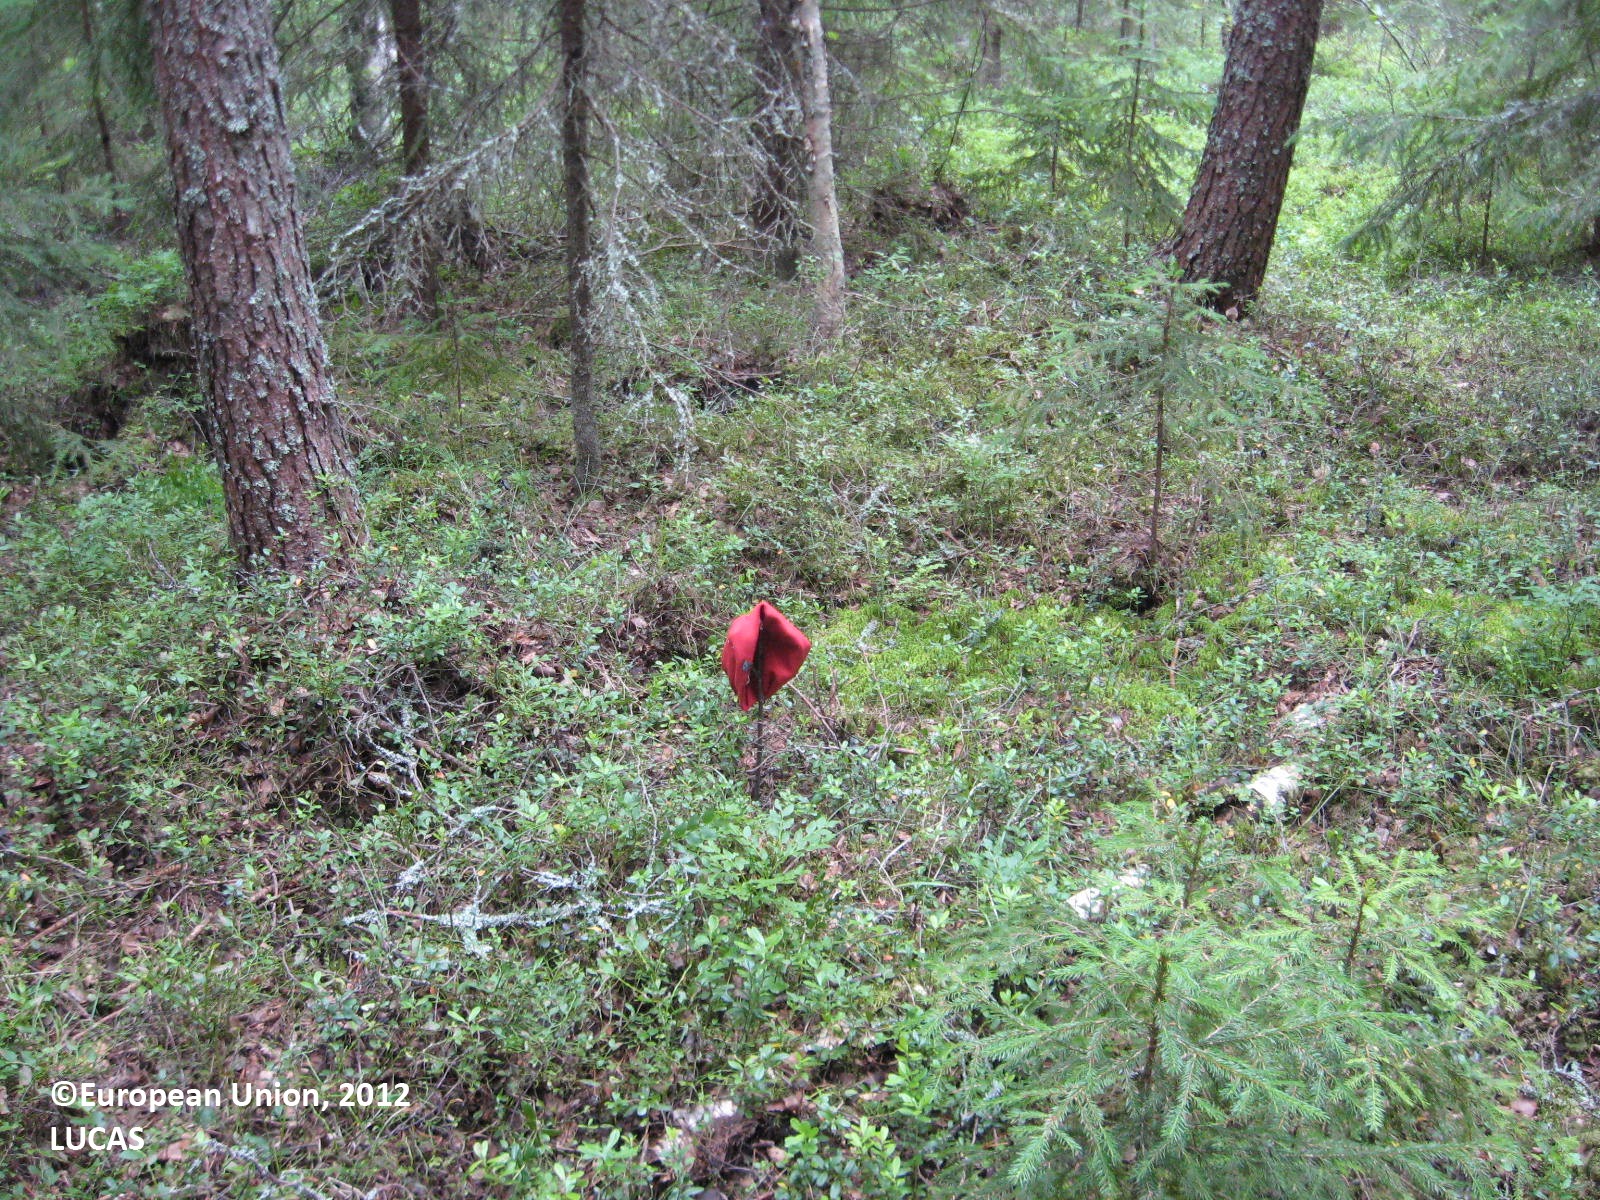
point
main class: Woodland
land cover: Spruce dominated coniferous woodland
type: boreal forest
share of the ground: > 75 %
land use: Forestry
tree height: > 5 m
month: July
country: FI
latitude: 62.5387
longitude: 21.2168
